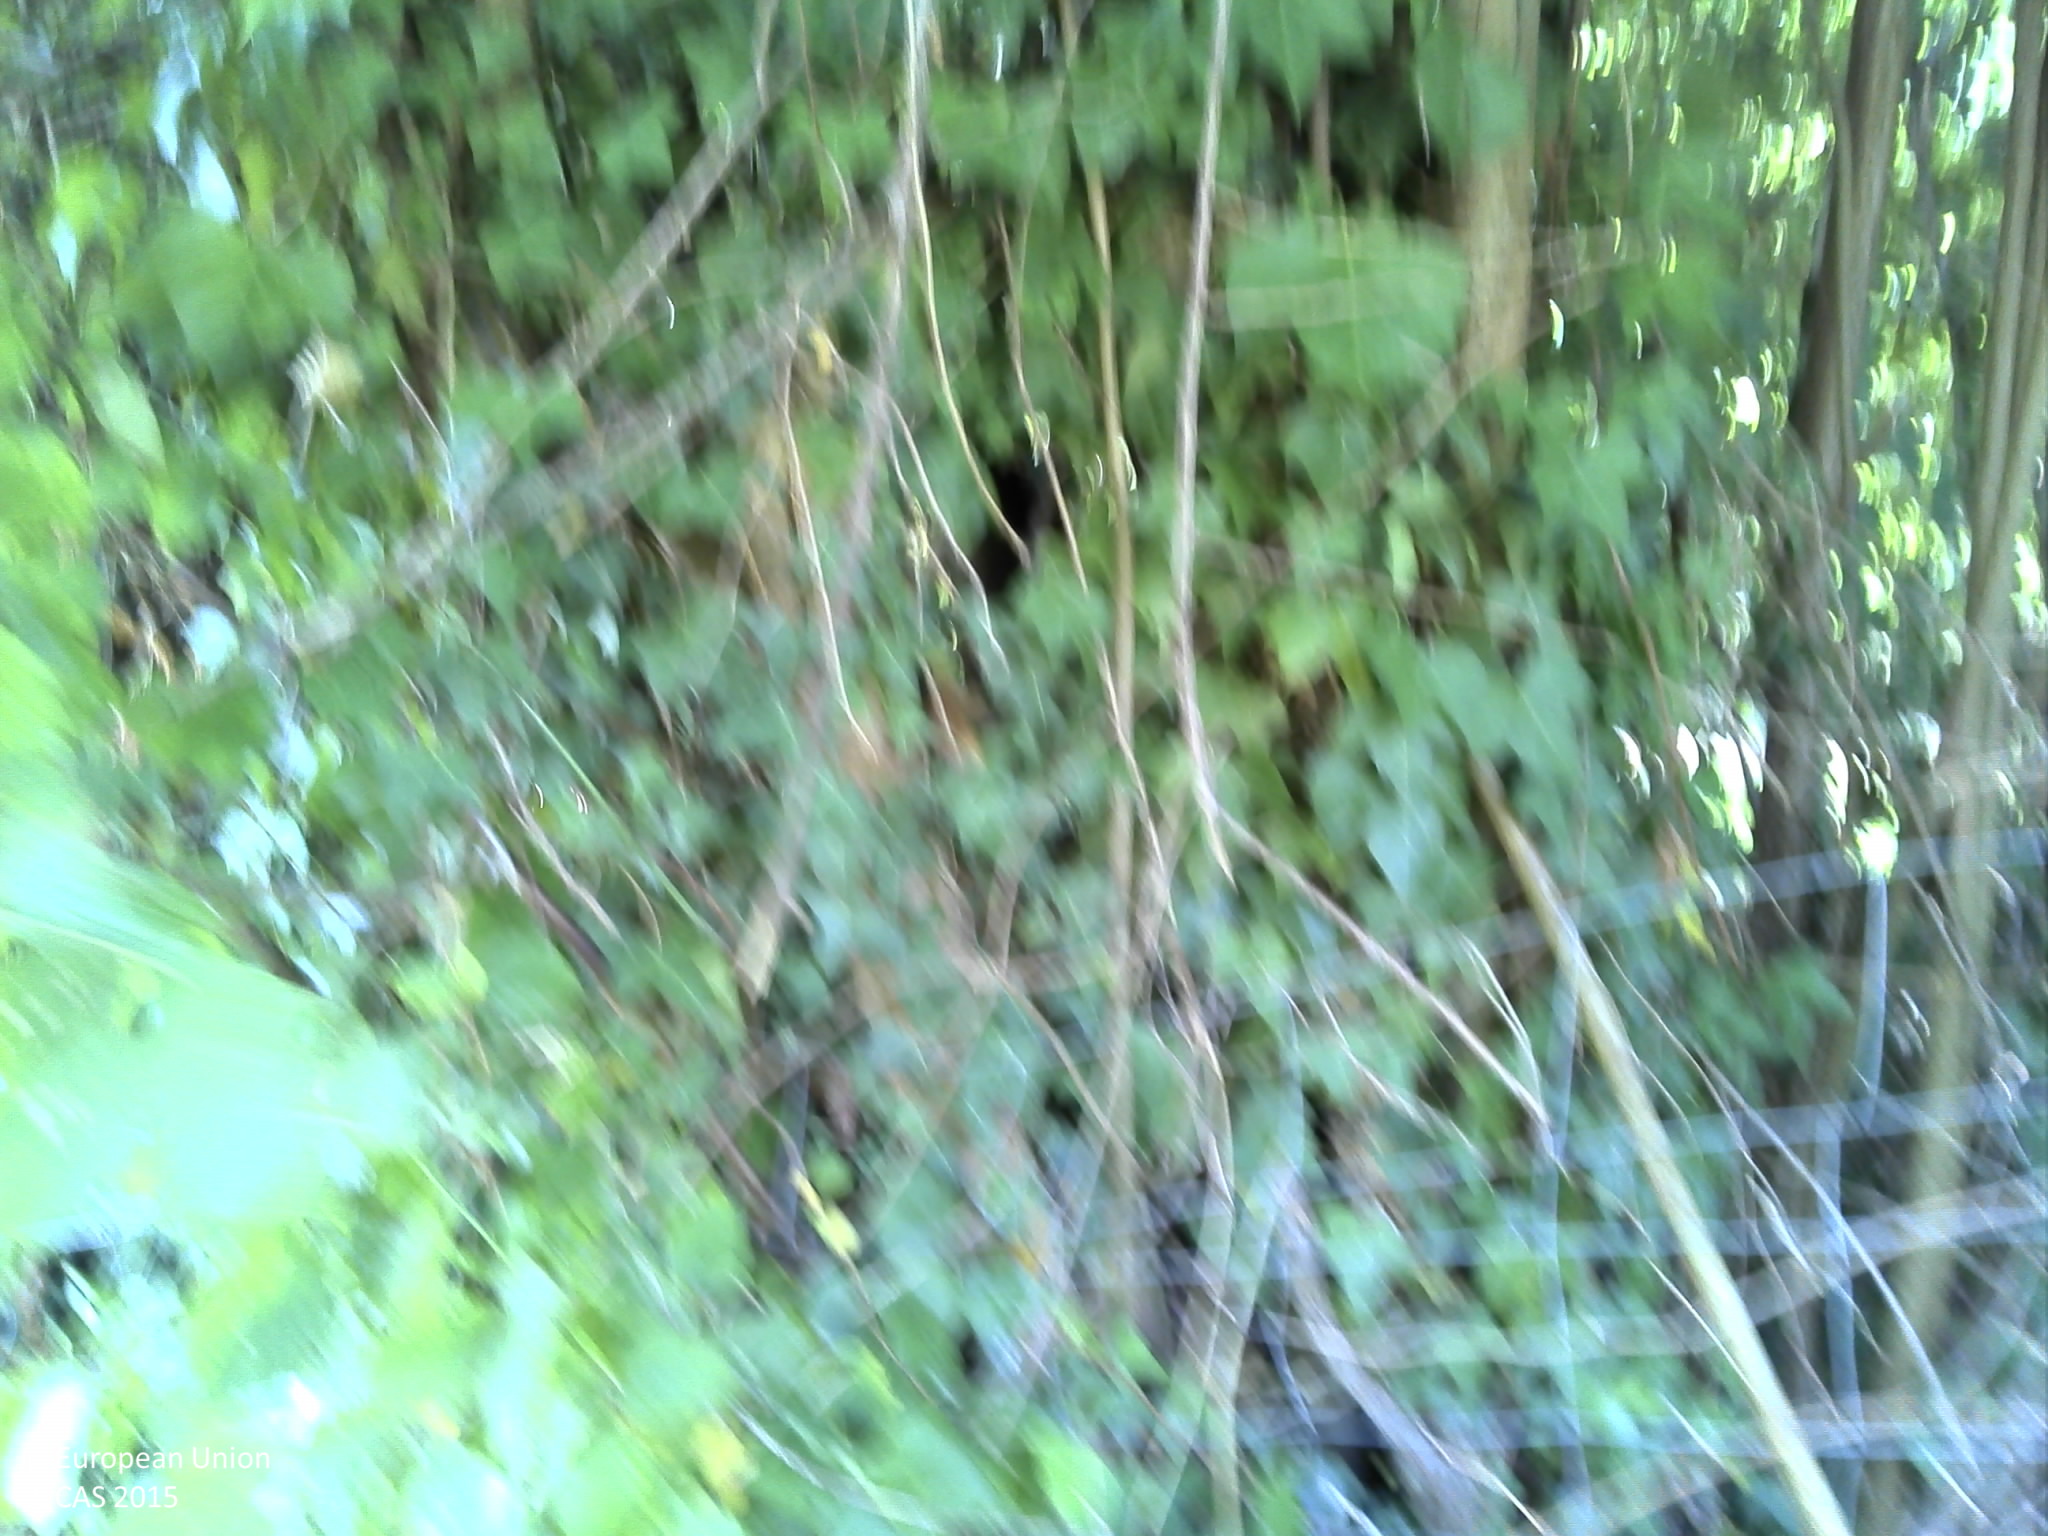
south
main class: Grassland
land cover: Grassland without tree/shrub cover
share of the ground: > 75 %
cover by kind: herbaceous plants 100 %
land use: Agriculture (excluding fallow land and kitchen gardens)
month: July
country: FR
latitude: 44.8590
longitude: -0.4323
